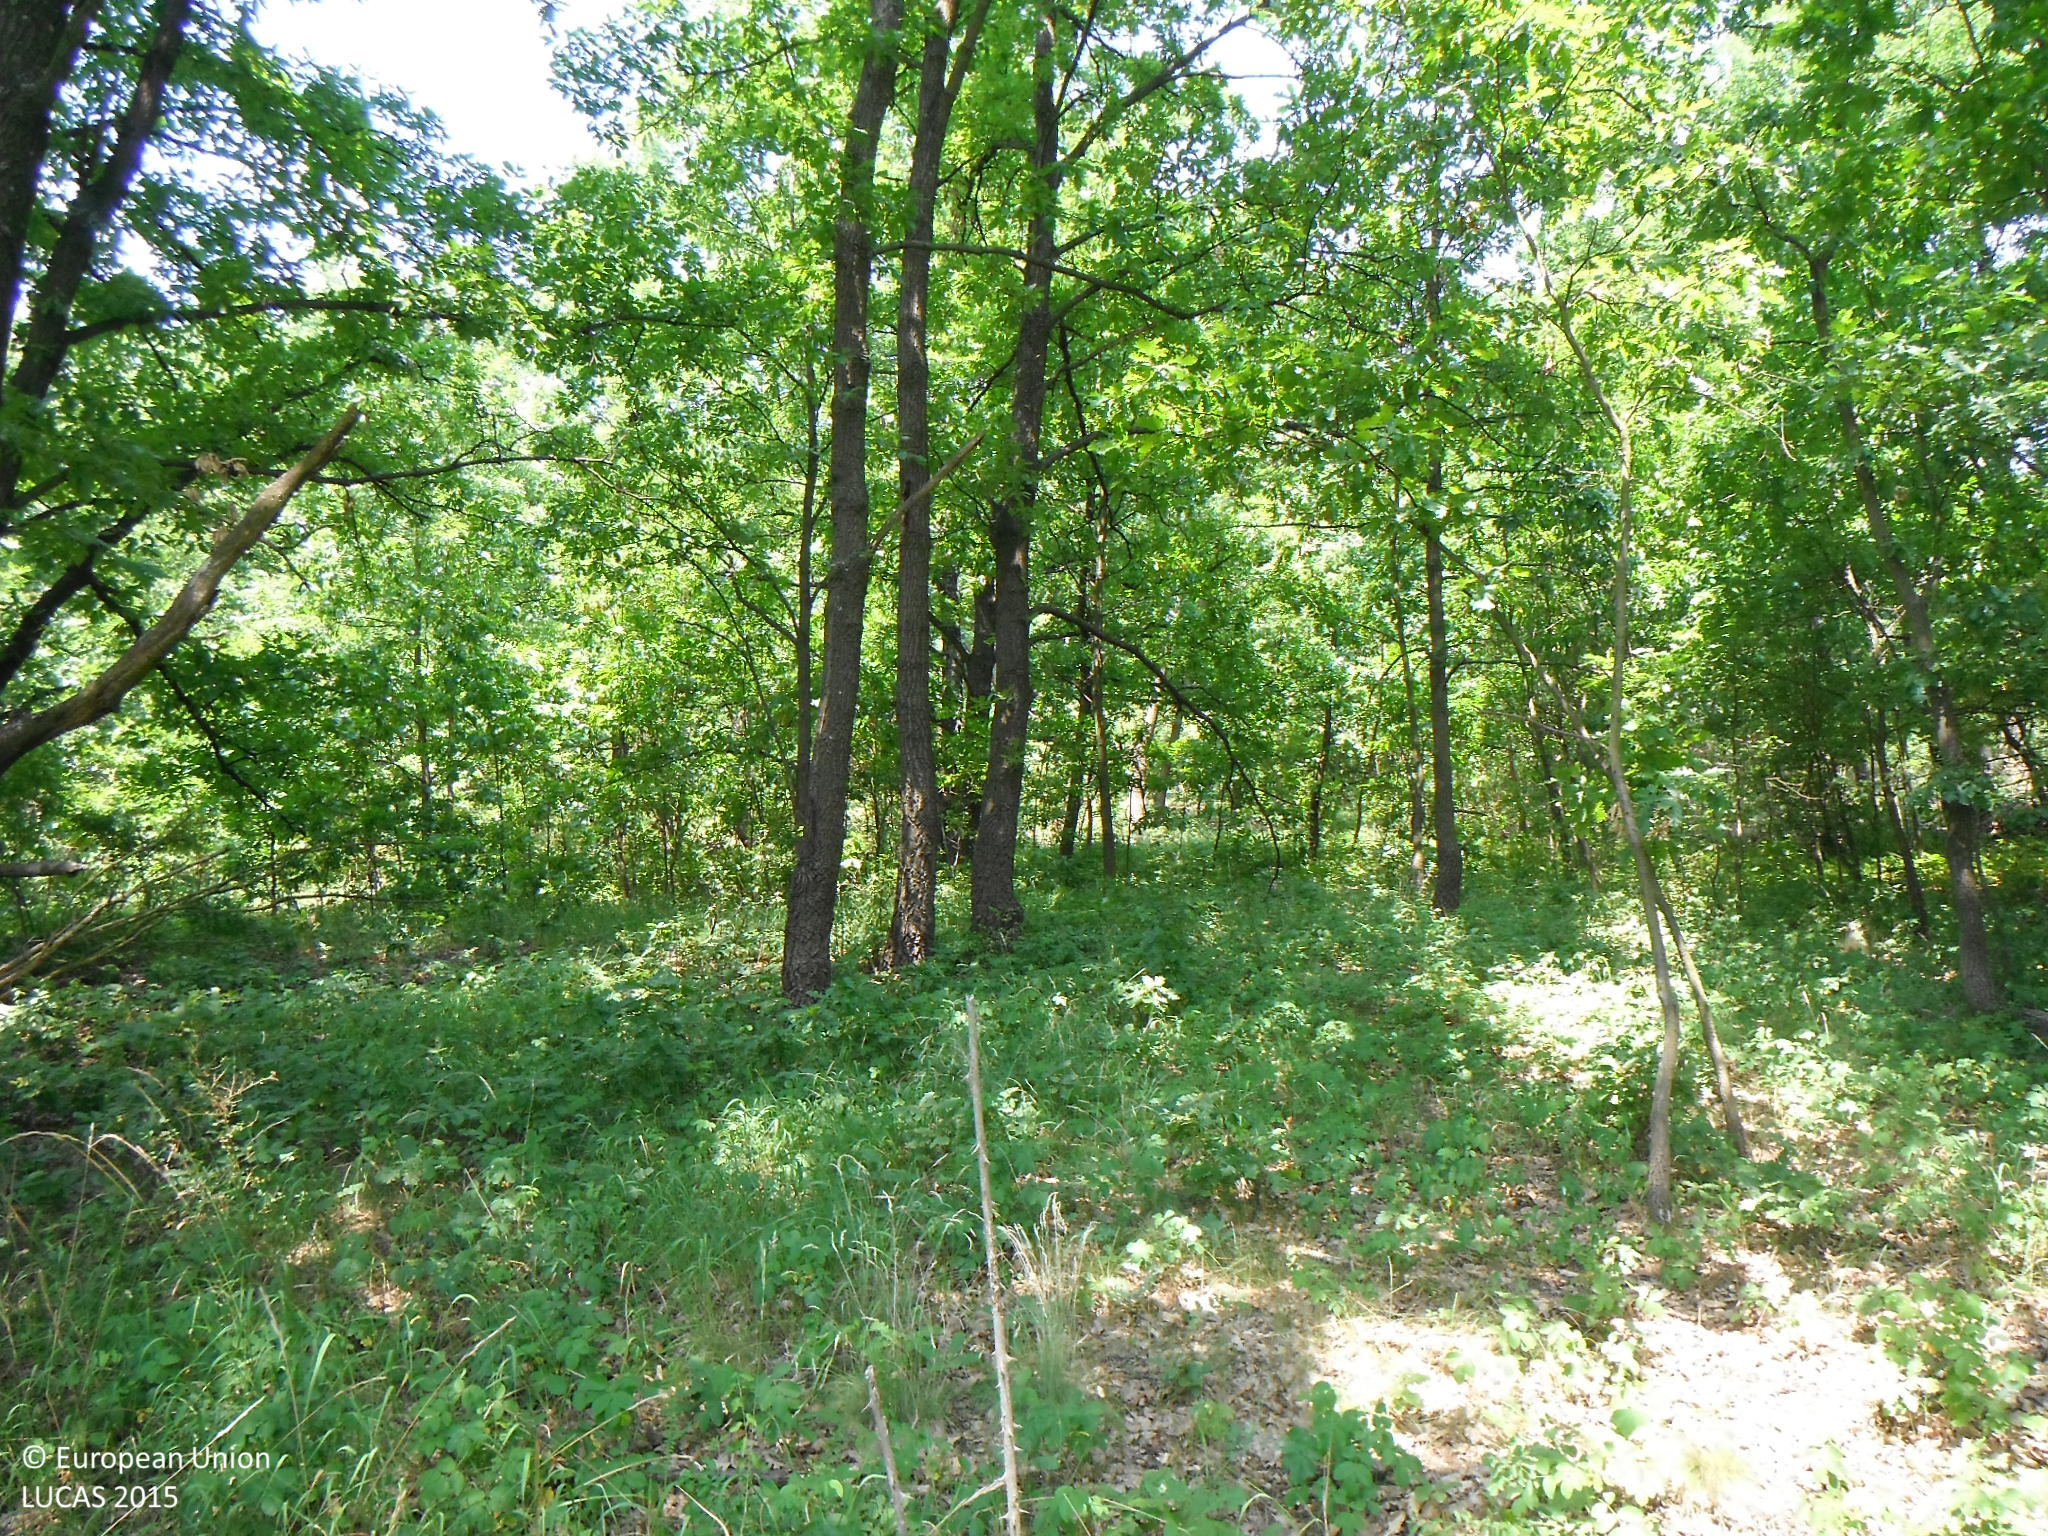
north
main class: Woodland
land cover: Broadleaved woodland
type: acidophilous oak and oak-birch forest
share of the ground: > 75 %
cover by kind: broadleaved forest trees 75 %, herbaceous plants 20 %, shrubs 5 %
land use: Forestry
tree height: > 5 m
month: July
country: SK
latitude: 48.0879
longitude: 19.0281
